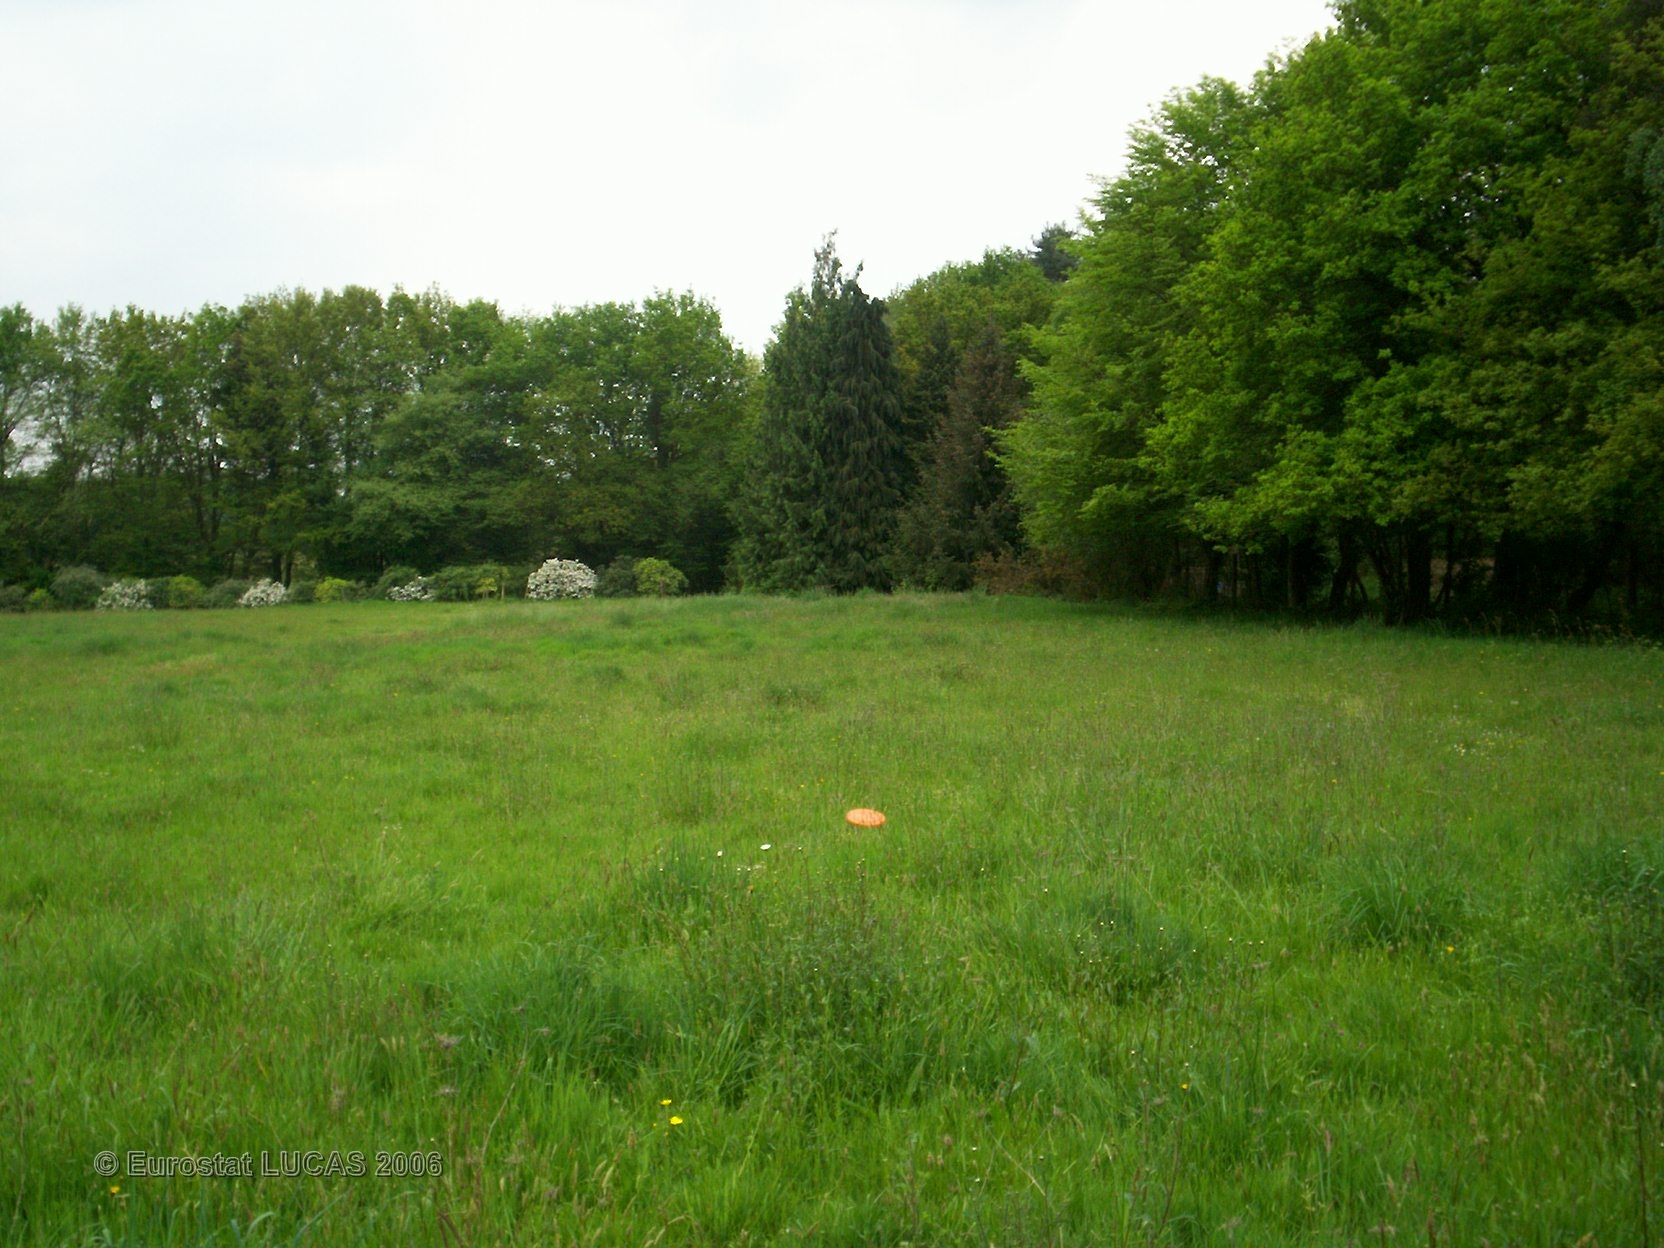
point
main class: Grassland
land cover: Grassland without tree/shrub cover
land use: Agriculture (excluding fallow land and kitchen gardens)
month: May
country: FR
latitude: 47.4917
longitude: -2.1704
